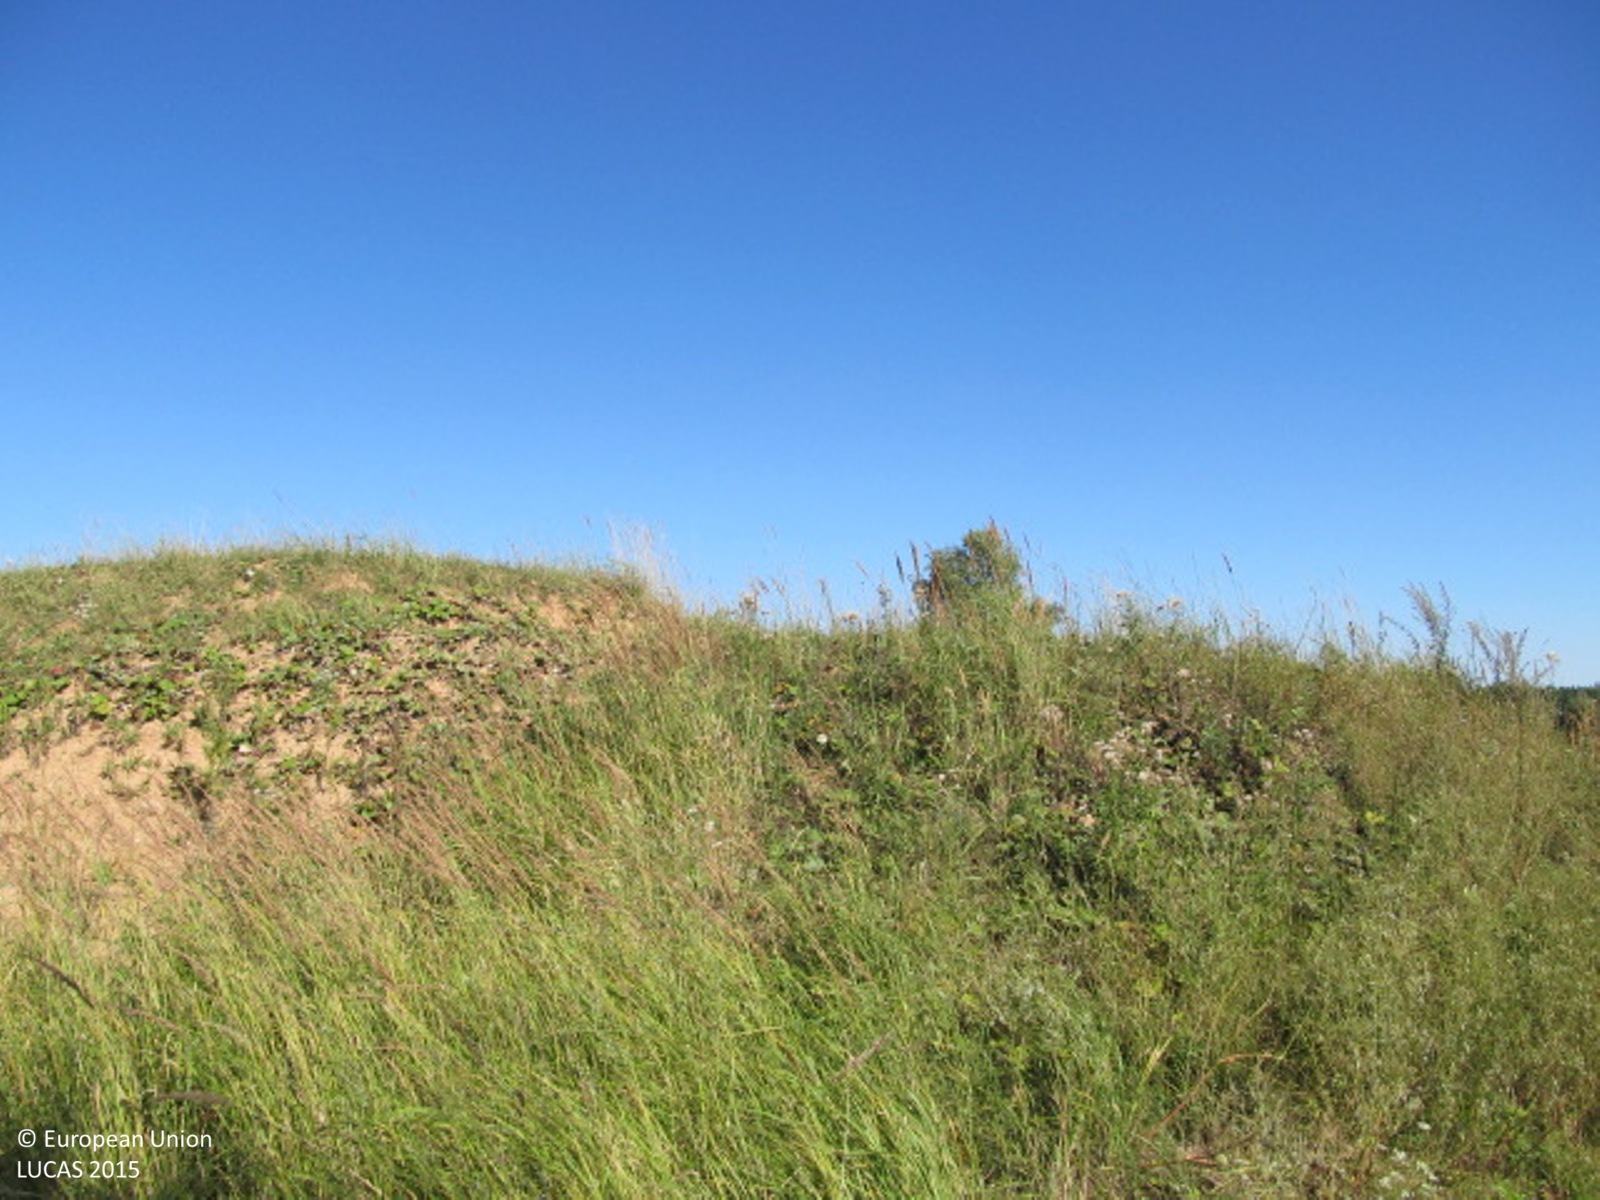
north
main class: Grassland
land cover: Spontaneously vegetated surfaces
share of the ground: 50 - 75 %
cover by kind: herbaceous plants 50 %, unconsolidated bare surface 45 %
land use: Amenities, museums, leisure
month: August
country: LT
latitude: 56.3099
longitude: 22.4226
